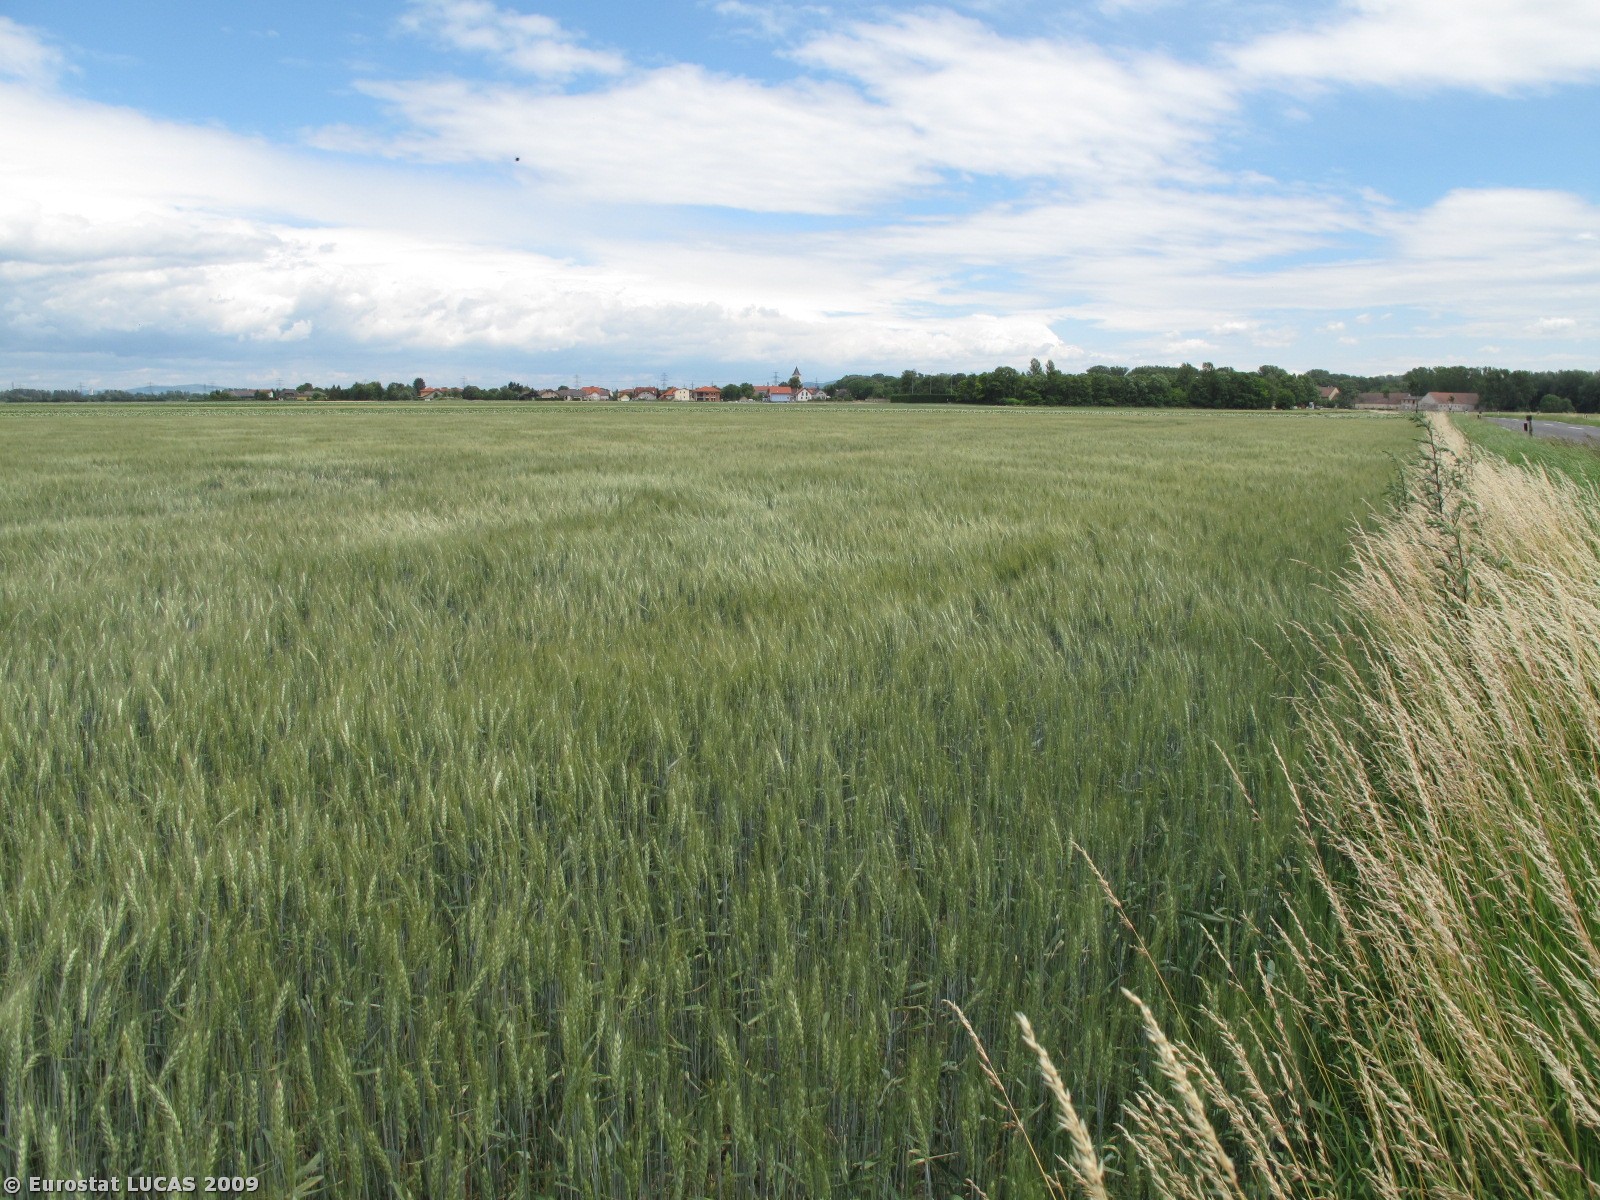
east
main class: Cropland
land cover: Triticale
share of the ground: > 75 %
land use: Agriculture (excluding fallow land and kitchen gardens)
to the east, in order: Triticale; Potatoes; Triticale; Common wheat
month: June
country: AT
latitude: 48.3663
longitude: 16.0108
